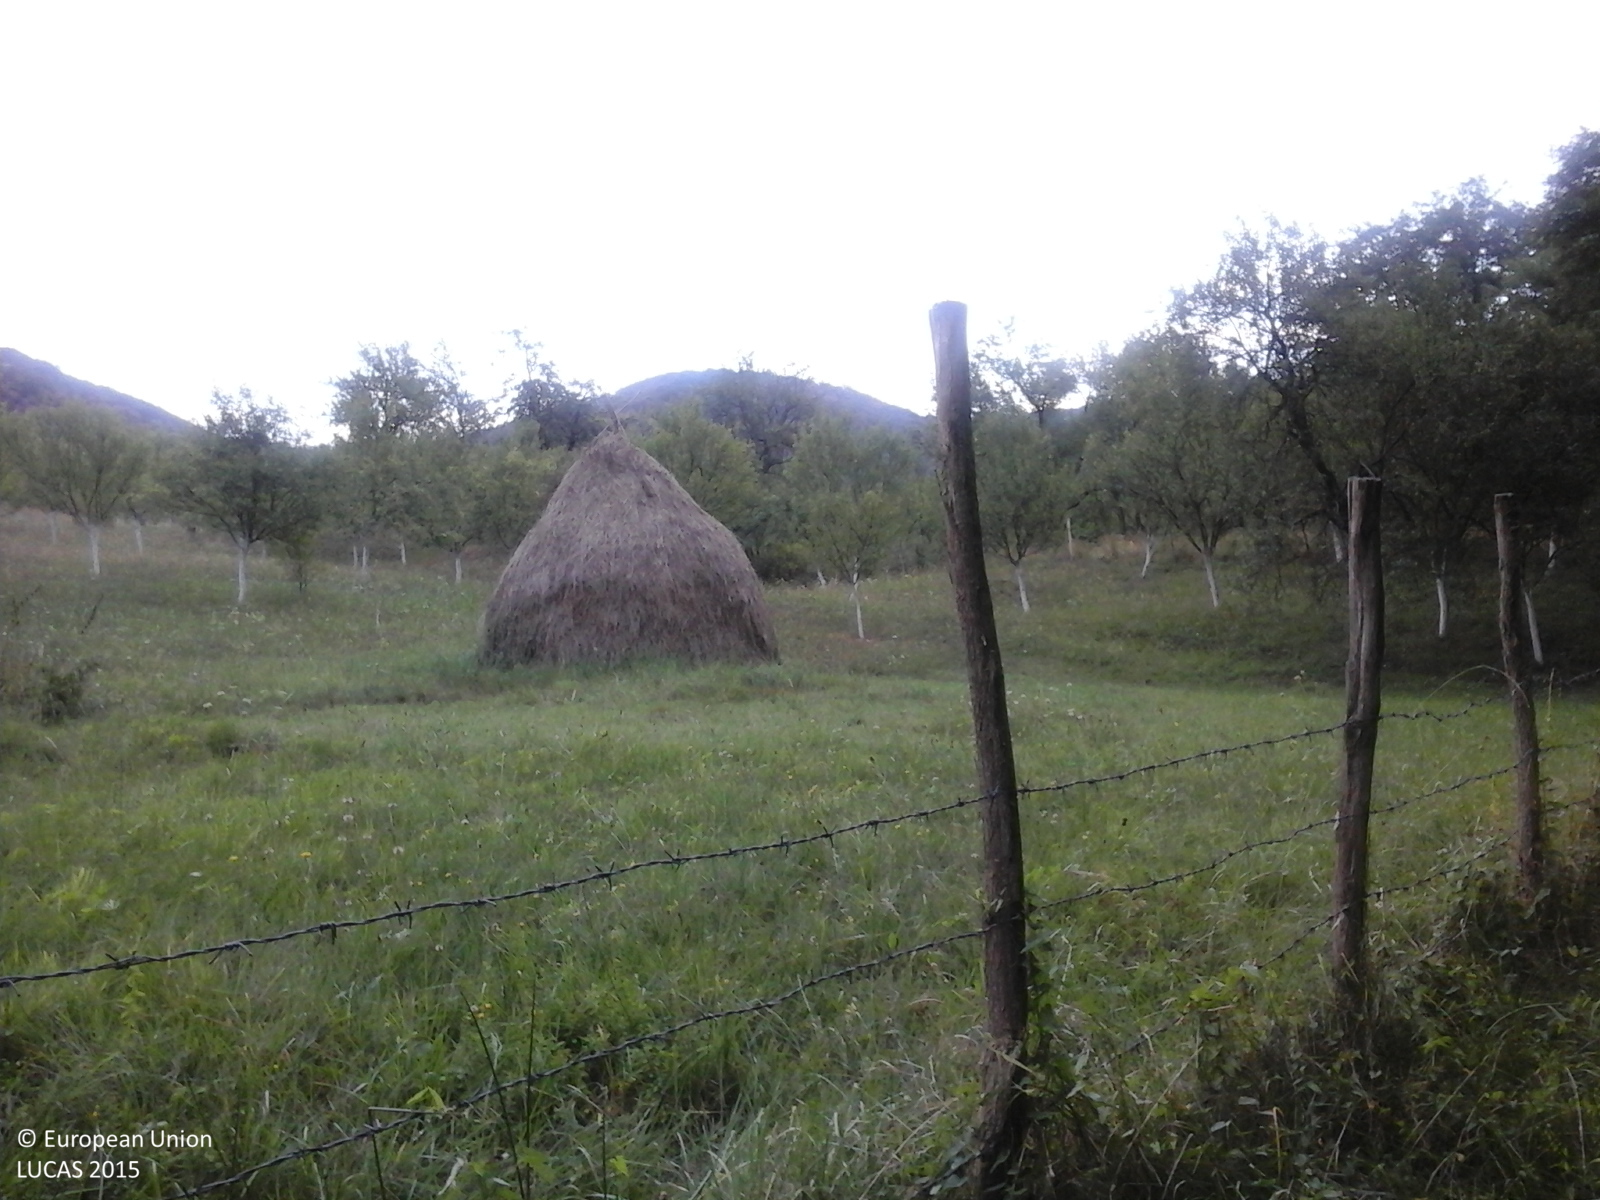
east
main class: Grassland
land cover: Grassland without tree/shrub cover
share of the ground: > 75 %
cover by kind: herbaceous plants 100 %
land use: Agriculture (excluding fallow land and kitchen gardens)
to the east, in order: Grassland without tree/shrub cover; Fences; Other fruit trees and berries; Tracks; Other fruit trees and berries
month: September
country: RO
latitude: 47.9710
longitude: 23.2119
